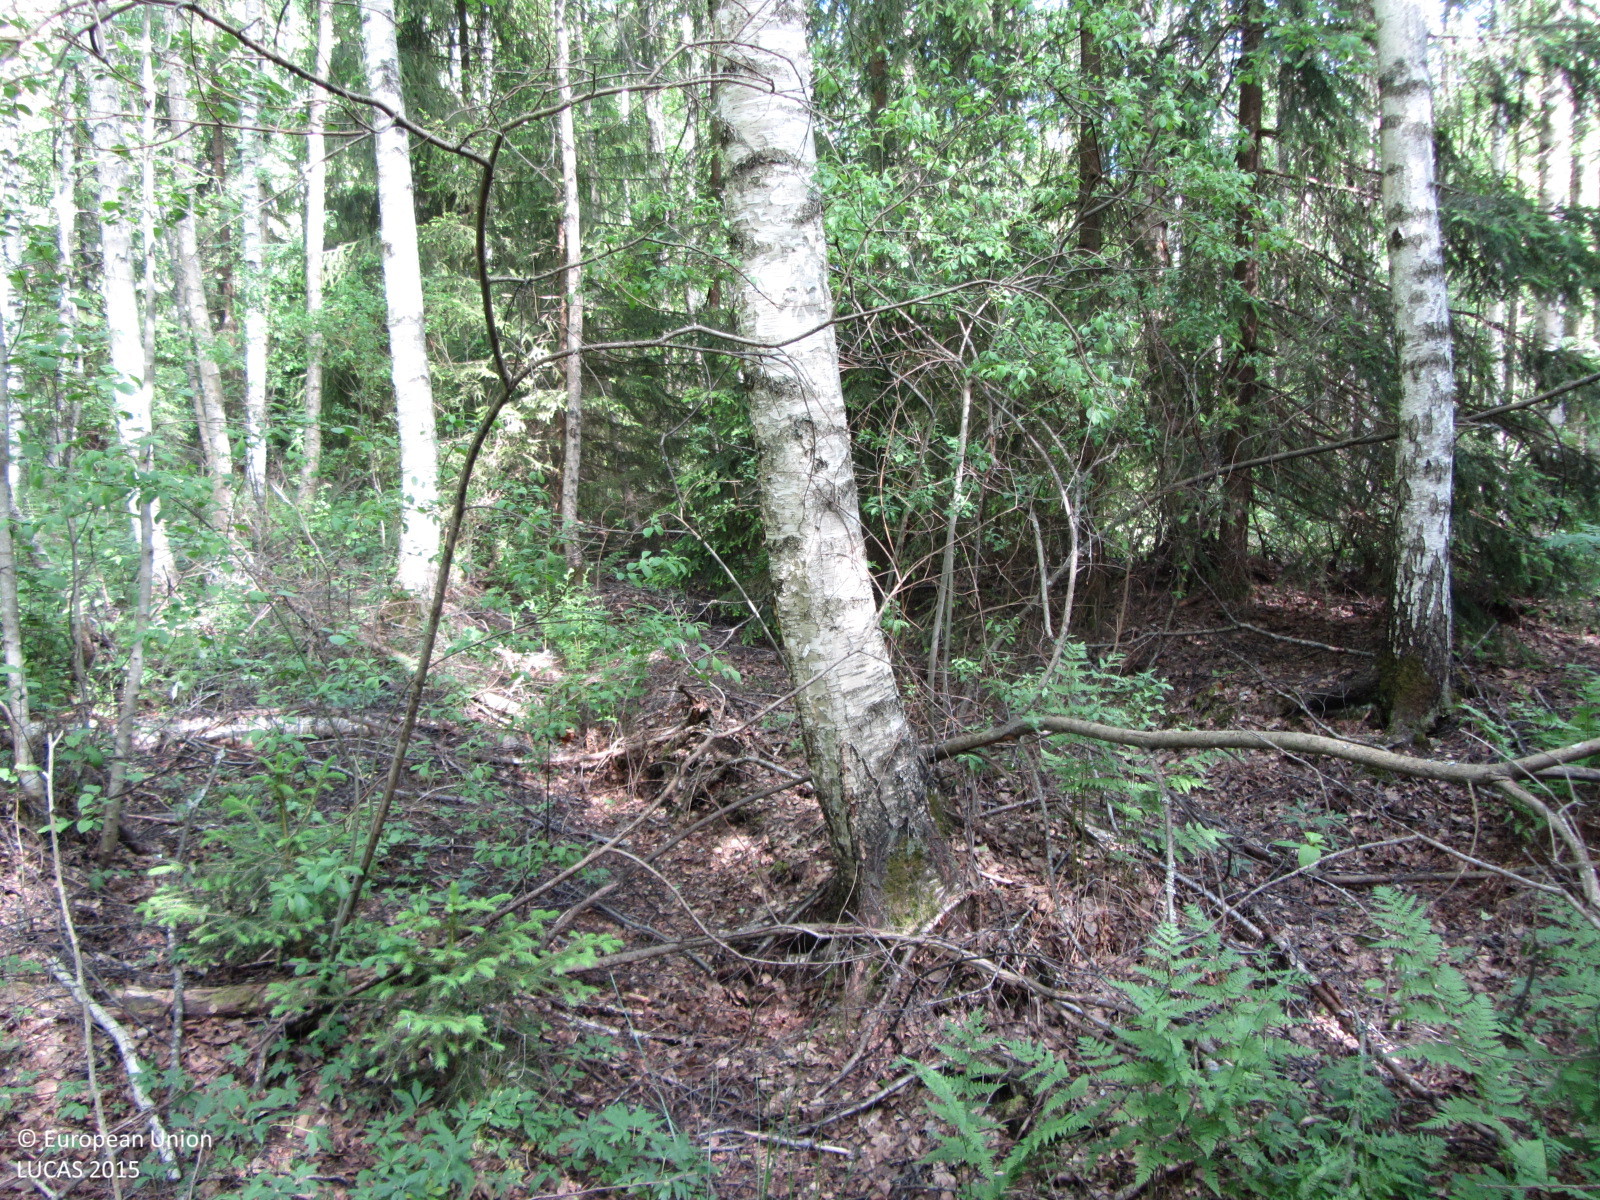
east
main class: Woodland
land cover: Broadleaved woodland
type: boreal forest
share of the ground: > 75 %
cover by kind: broadleaved forest trees 85 %, coniferous forest trees 10 %, herbaceous plants 5 %
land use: Forestry
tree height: > 5 m
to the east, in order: Broadleaved woodland; Spontaneously vegetated surfaces; Electric lines; Spontaneously vegetated surfaces; Spruce dominated mixed woodland; Tracks; Spruce dominated mixed woodland; Ditches and canals; Fences; Grassland without tree/shrub cover; Fences; Broadleaved woodland; Electric lines; Broadleaved woodland; Grassland without tree/shrub cover; Fences; Broadleaved woodland; Grass margins; Paved roads, cycling and walking lanes; Grass margins; Ditches and canals; Broadleaved woodland; Artificial constructions in urban areas; Ditches and canals; Broadleaved woodland
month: June
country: FI
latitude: 60.2937
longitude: 24.2680
